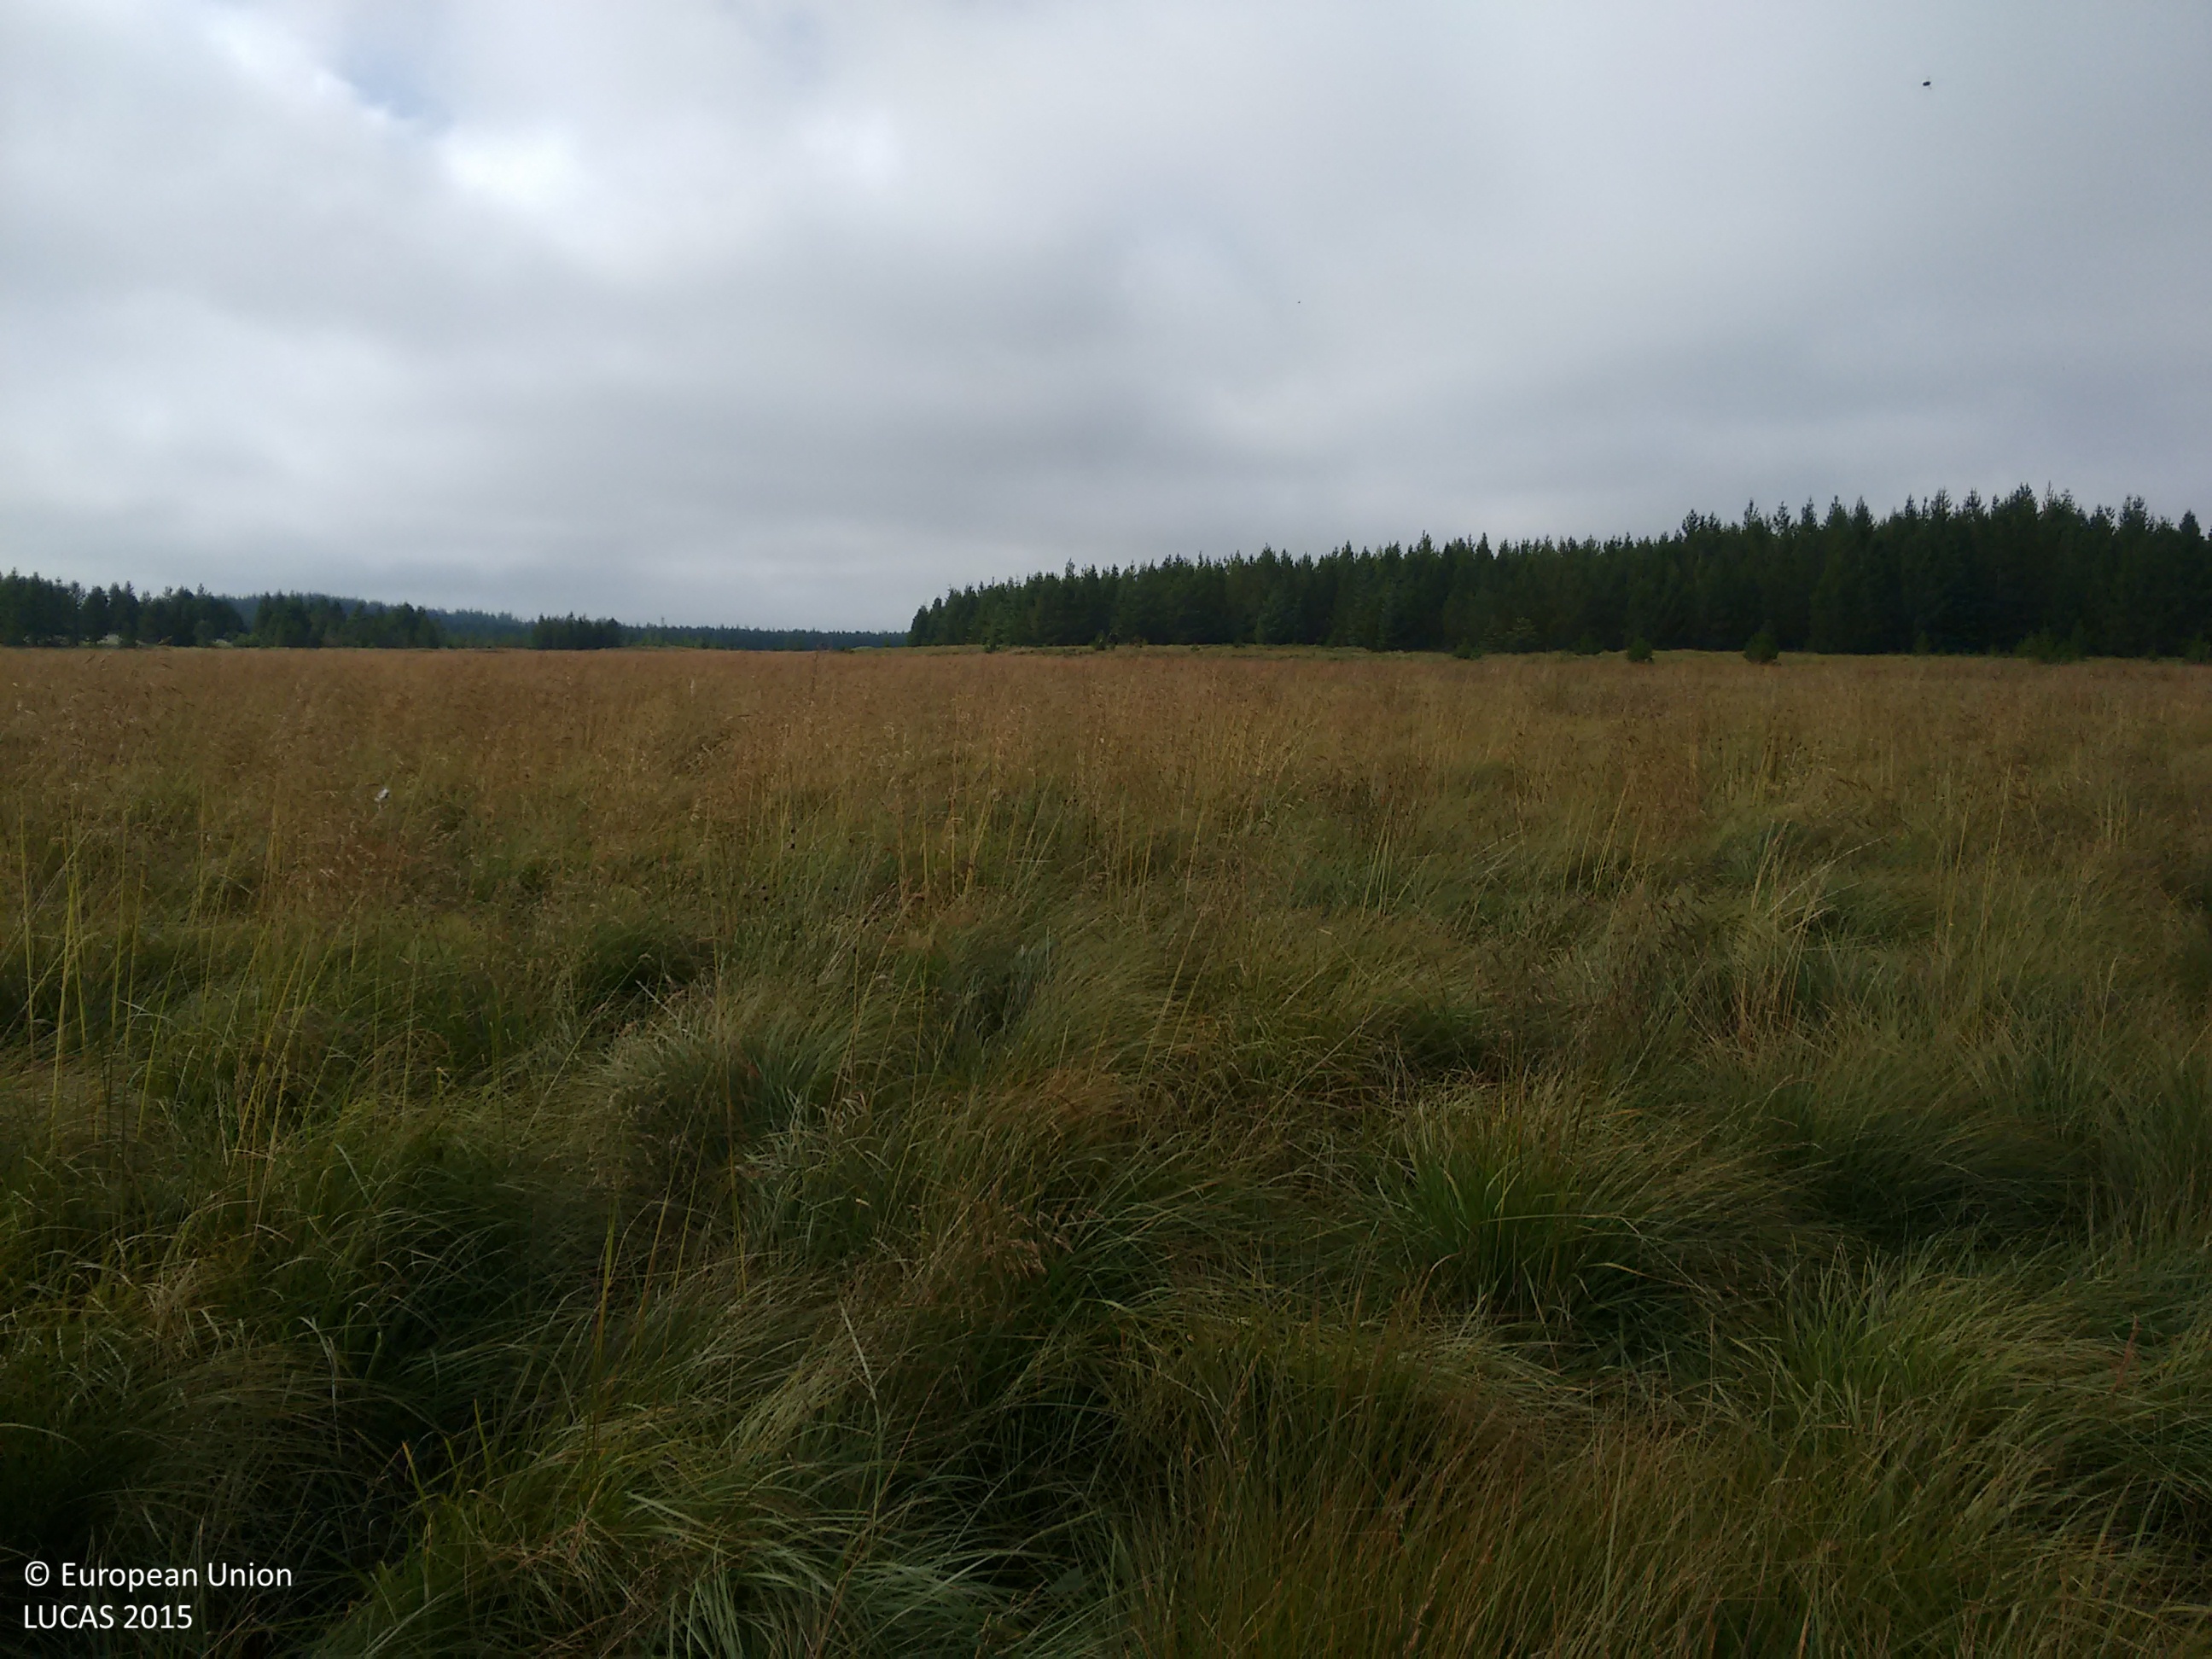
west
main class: Grassland
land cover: Grassland without tree/shrub cover
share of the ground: > 75 %
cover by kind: herbaceous plants 100 %
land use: Agriculture (excluding fallow land and kitchen gardens)
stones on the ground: < 10 %
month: September
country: GB
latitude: 58.0991
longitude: -4.3876
